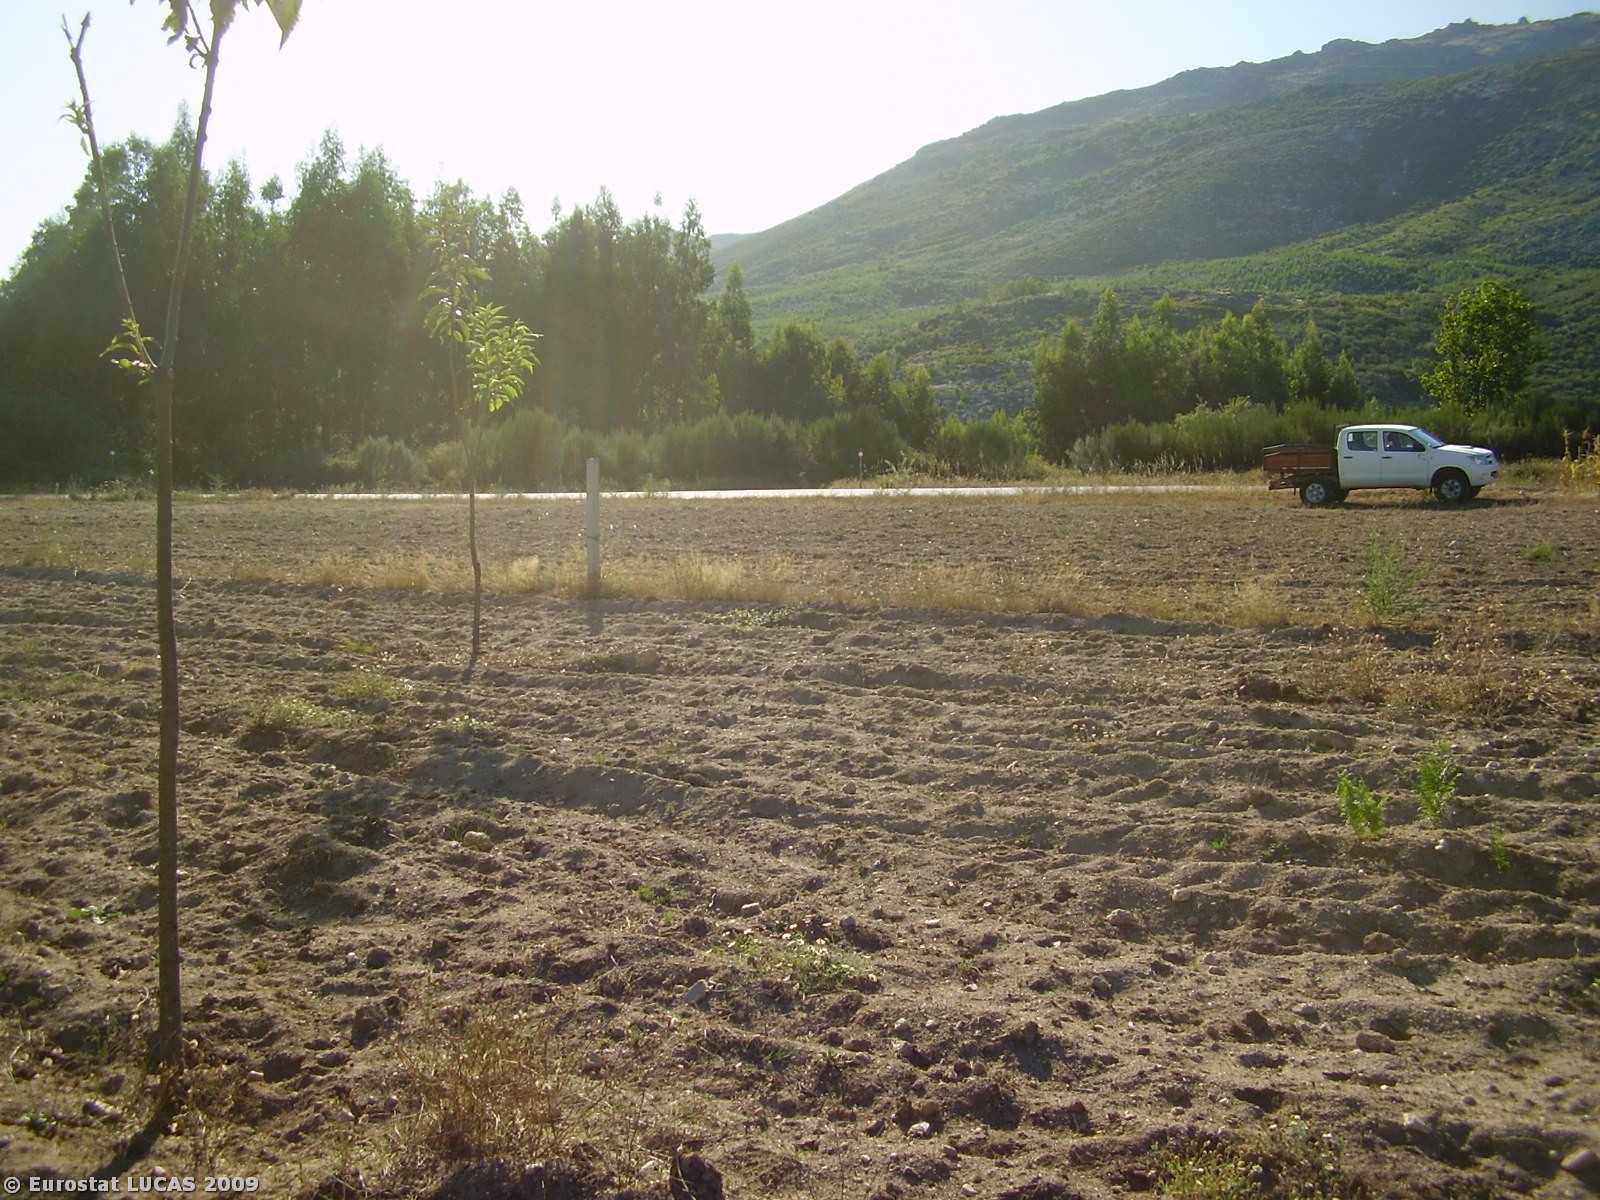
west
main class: Cropland
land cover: Other fruit trees and berries
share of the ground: 10 - 25 %
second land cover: Spontaneously vegetated surfaces
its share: 10 - 25 %
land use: Agriculture (excluding fallow land and kitchen gardens)
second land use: Fallow land
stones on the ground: 25 - 50 %
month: September
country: PT
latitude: 41.7213
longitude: -7.6237
